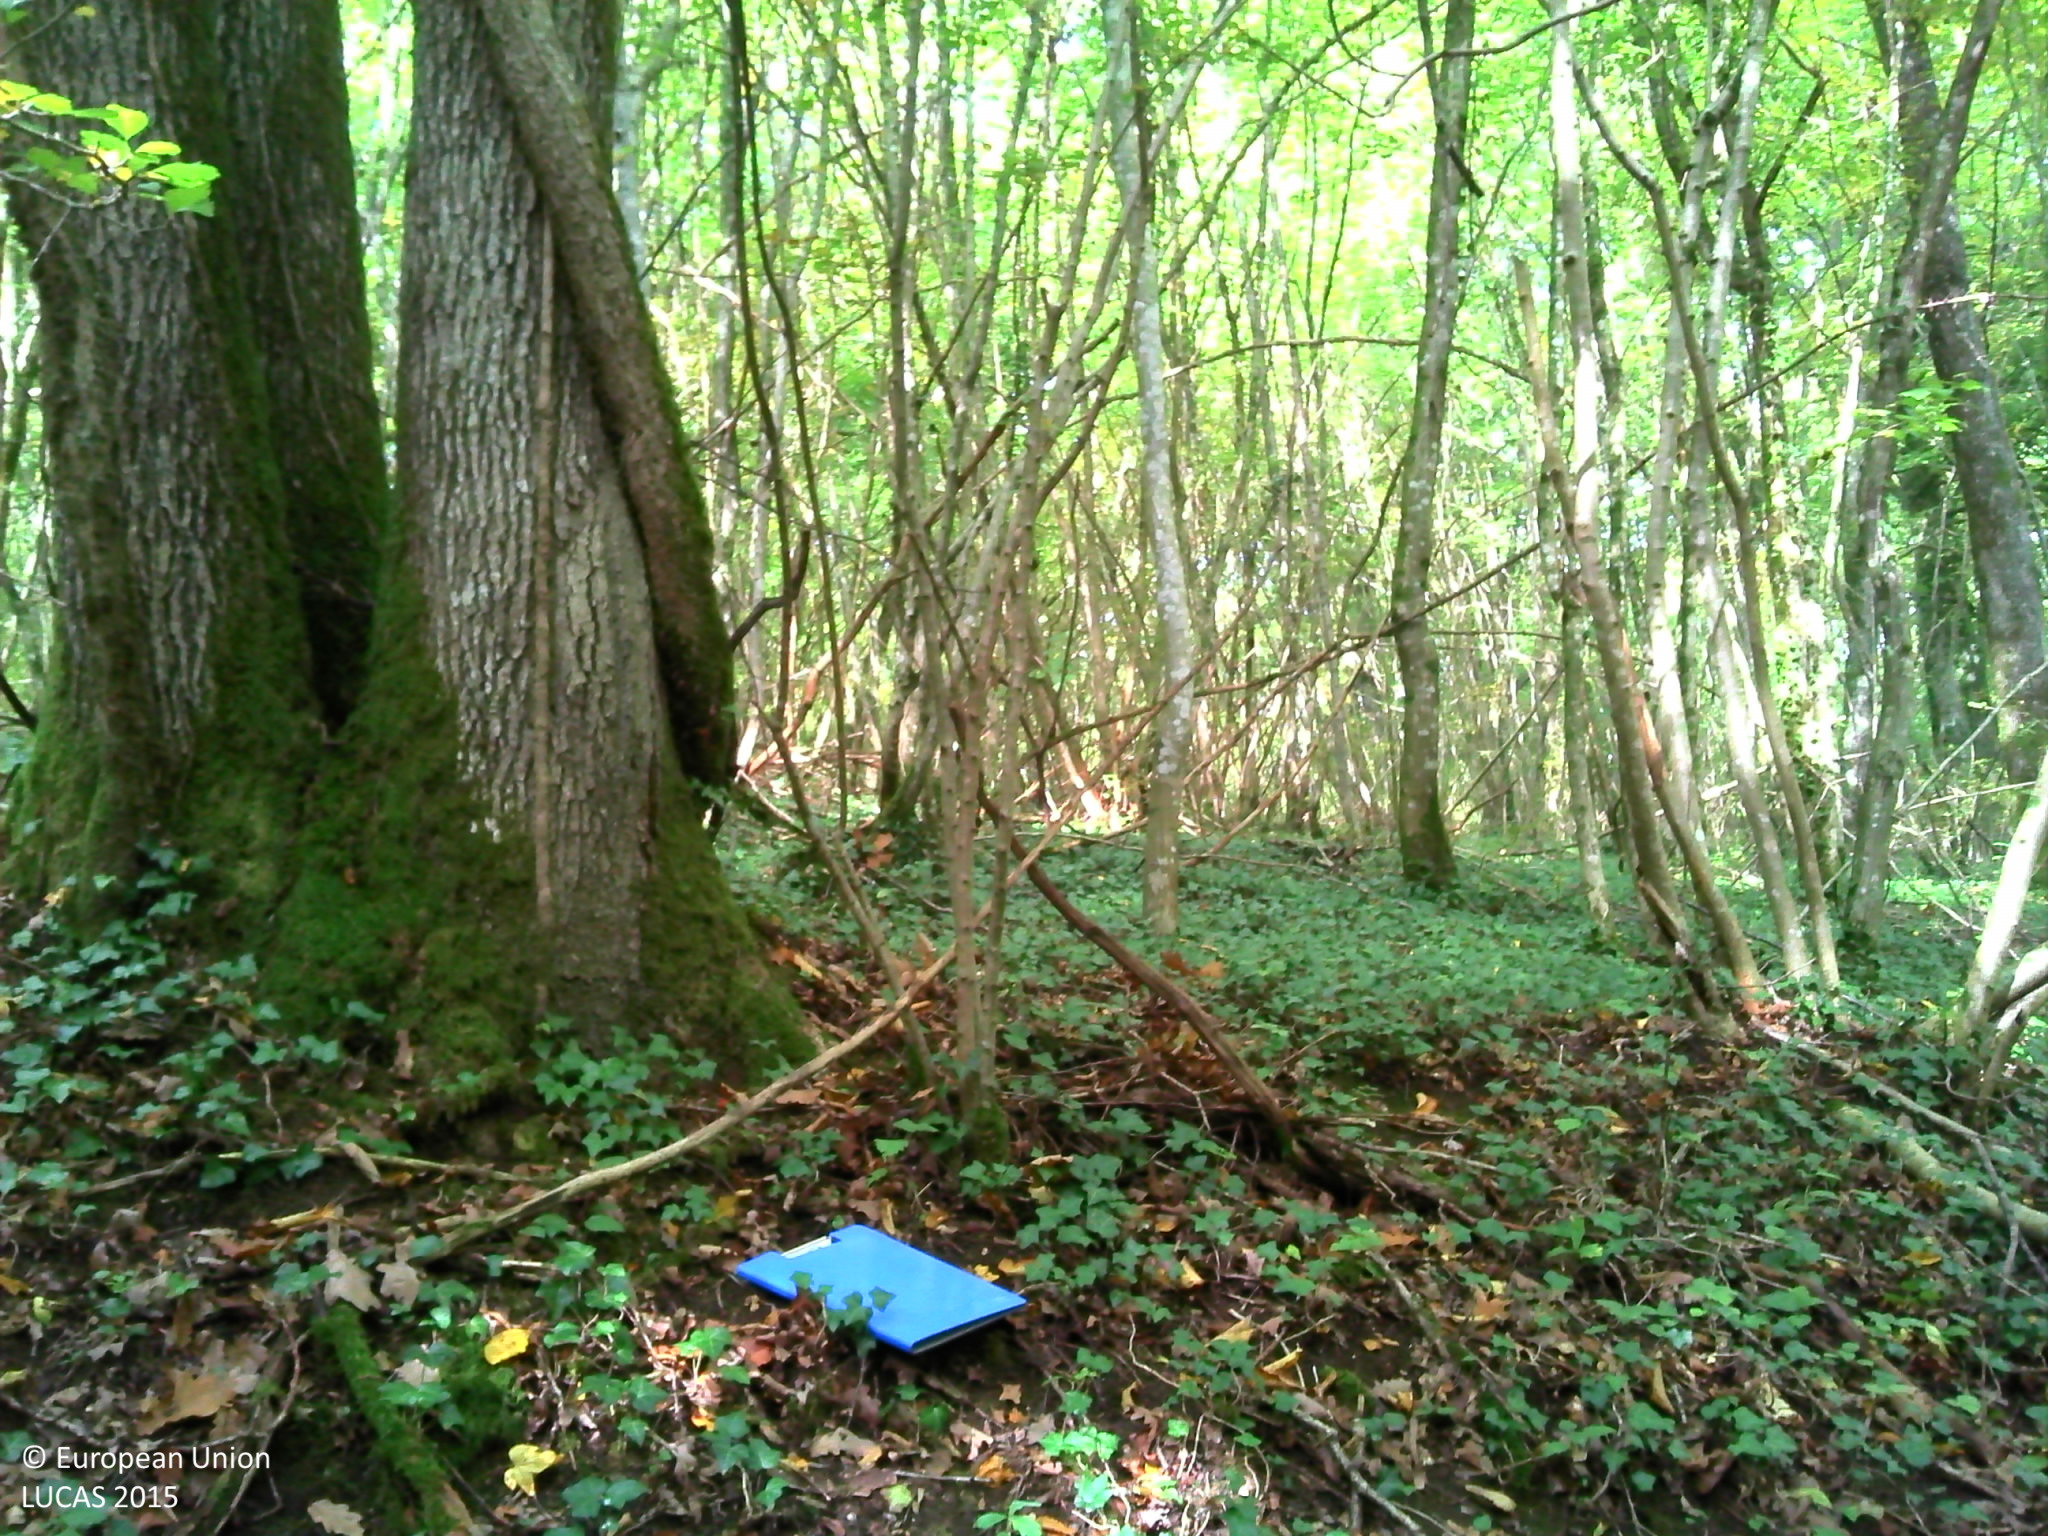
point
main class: Woodland
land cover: Broadleaved woodland
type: mesophytic deciduous forest
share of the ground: > 75 %
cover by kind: broadleaved forest trees 90 %, herbaceous plants 10 %
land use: Forestry
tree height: > 5 m
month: October
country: FR
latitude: 49.6062
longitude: 5.0019
